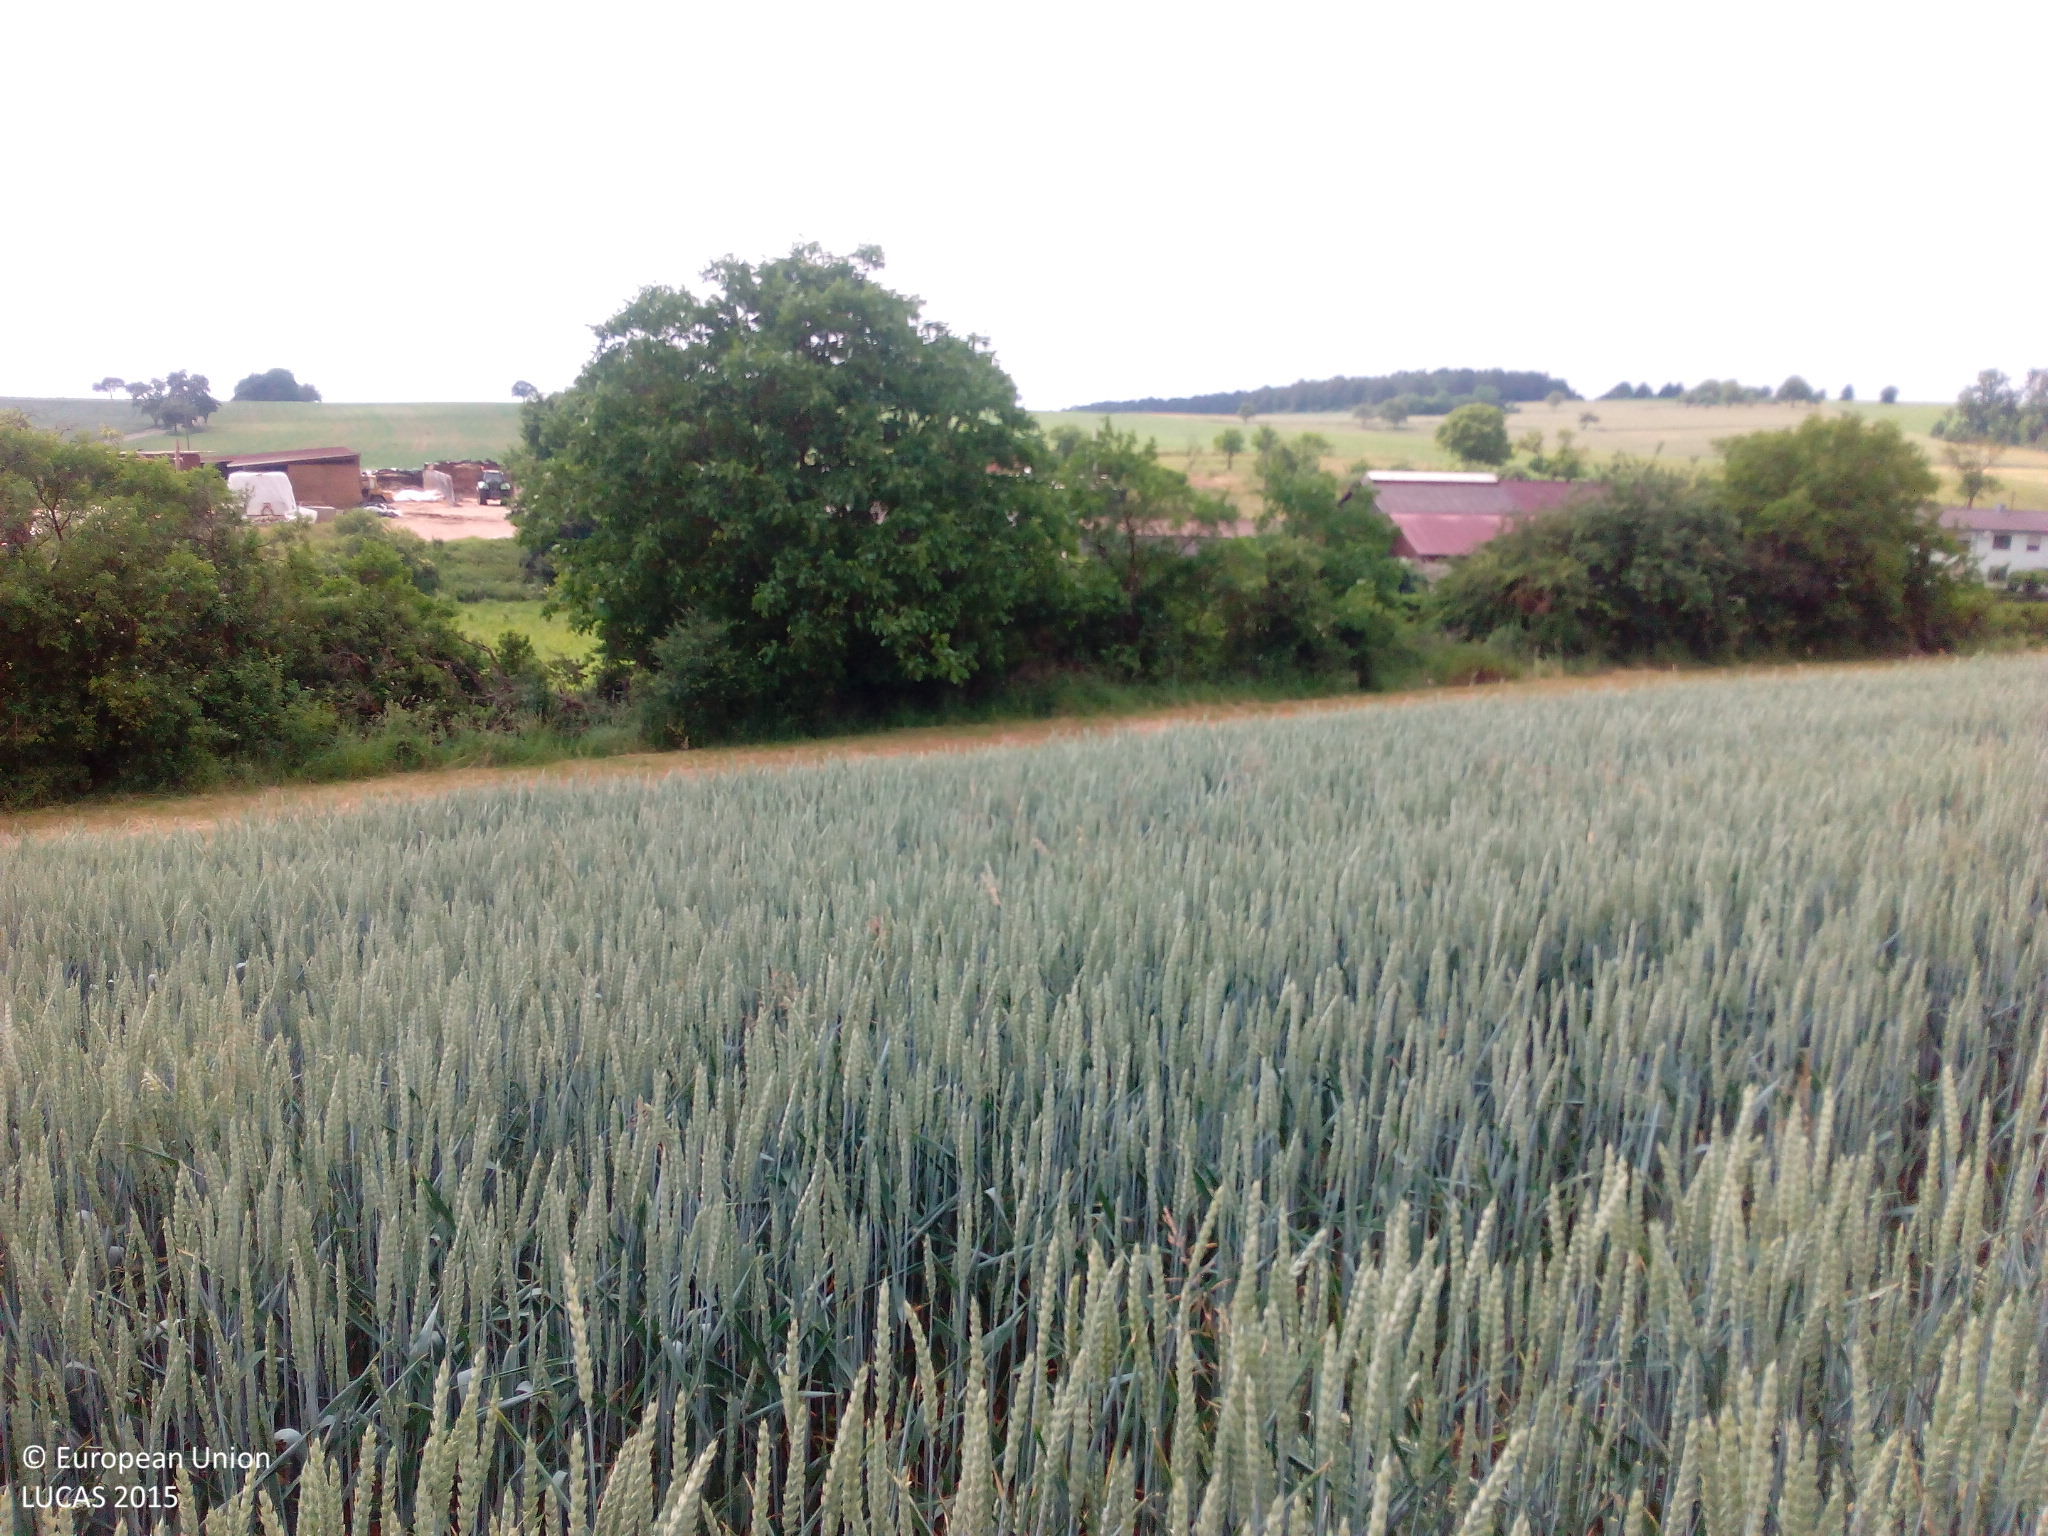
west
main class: Cropland
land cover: Common wheat
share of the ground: > 75 %
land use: Agriculture (excluding fallow land and kitchen gardens)
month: June
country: DE
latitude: 49.4265
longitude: 9.2696
